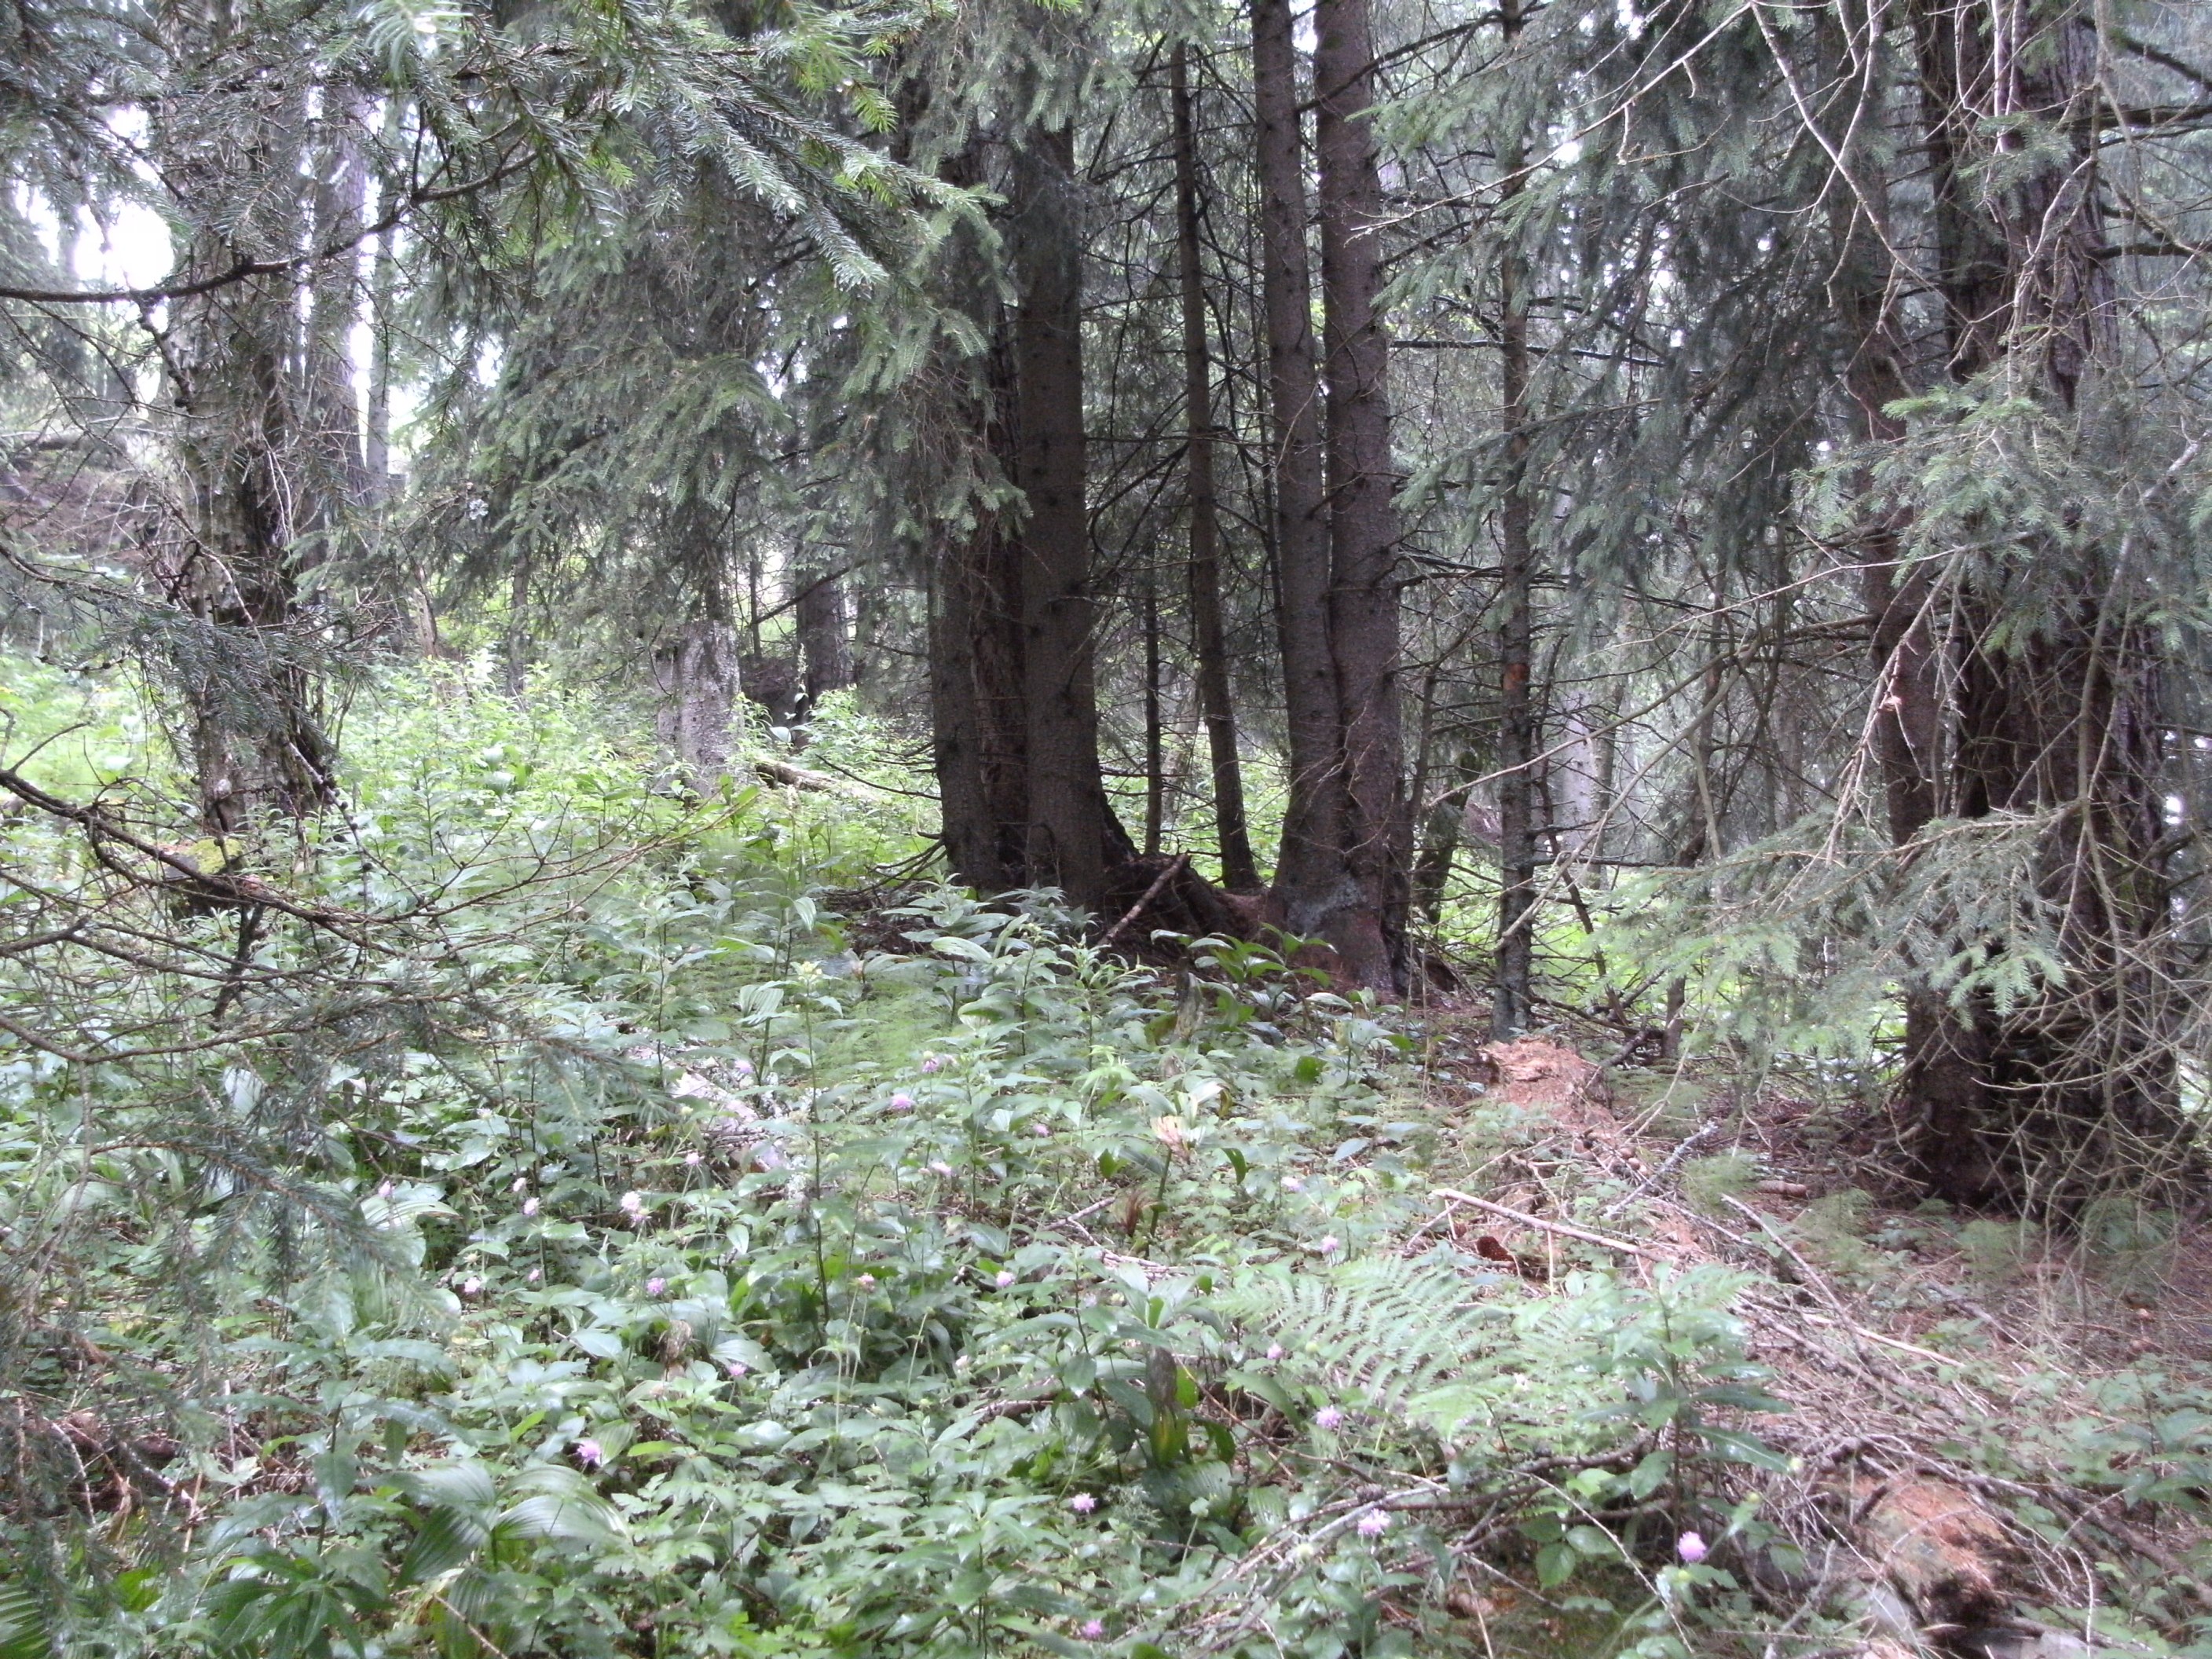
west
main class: Woodland
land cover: Spruce dominated coniferous woodland
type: alpine coniferous forest
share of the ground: 50 - 75 %
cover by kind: coniferous forest trees 60 %, herbaceous plants 30 %, unconsolidated bare surface 10 %
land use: Forestry
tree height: > 5 m
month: July
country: AT
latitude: 46.9316
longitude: 14.7400
